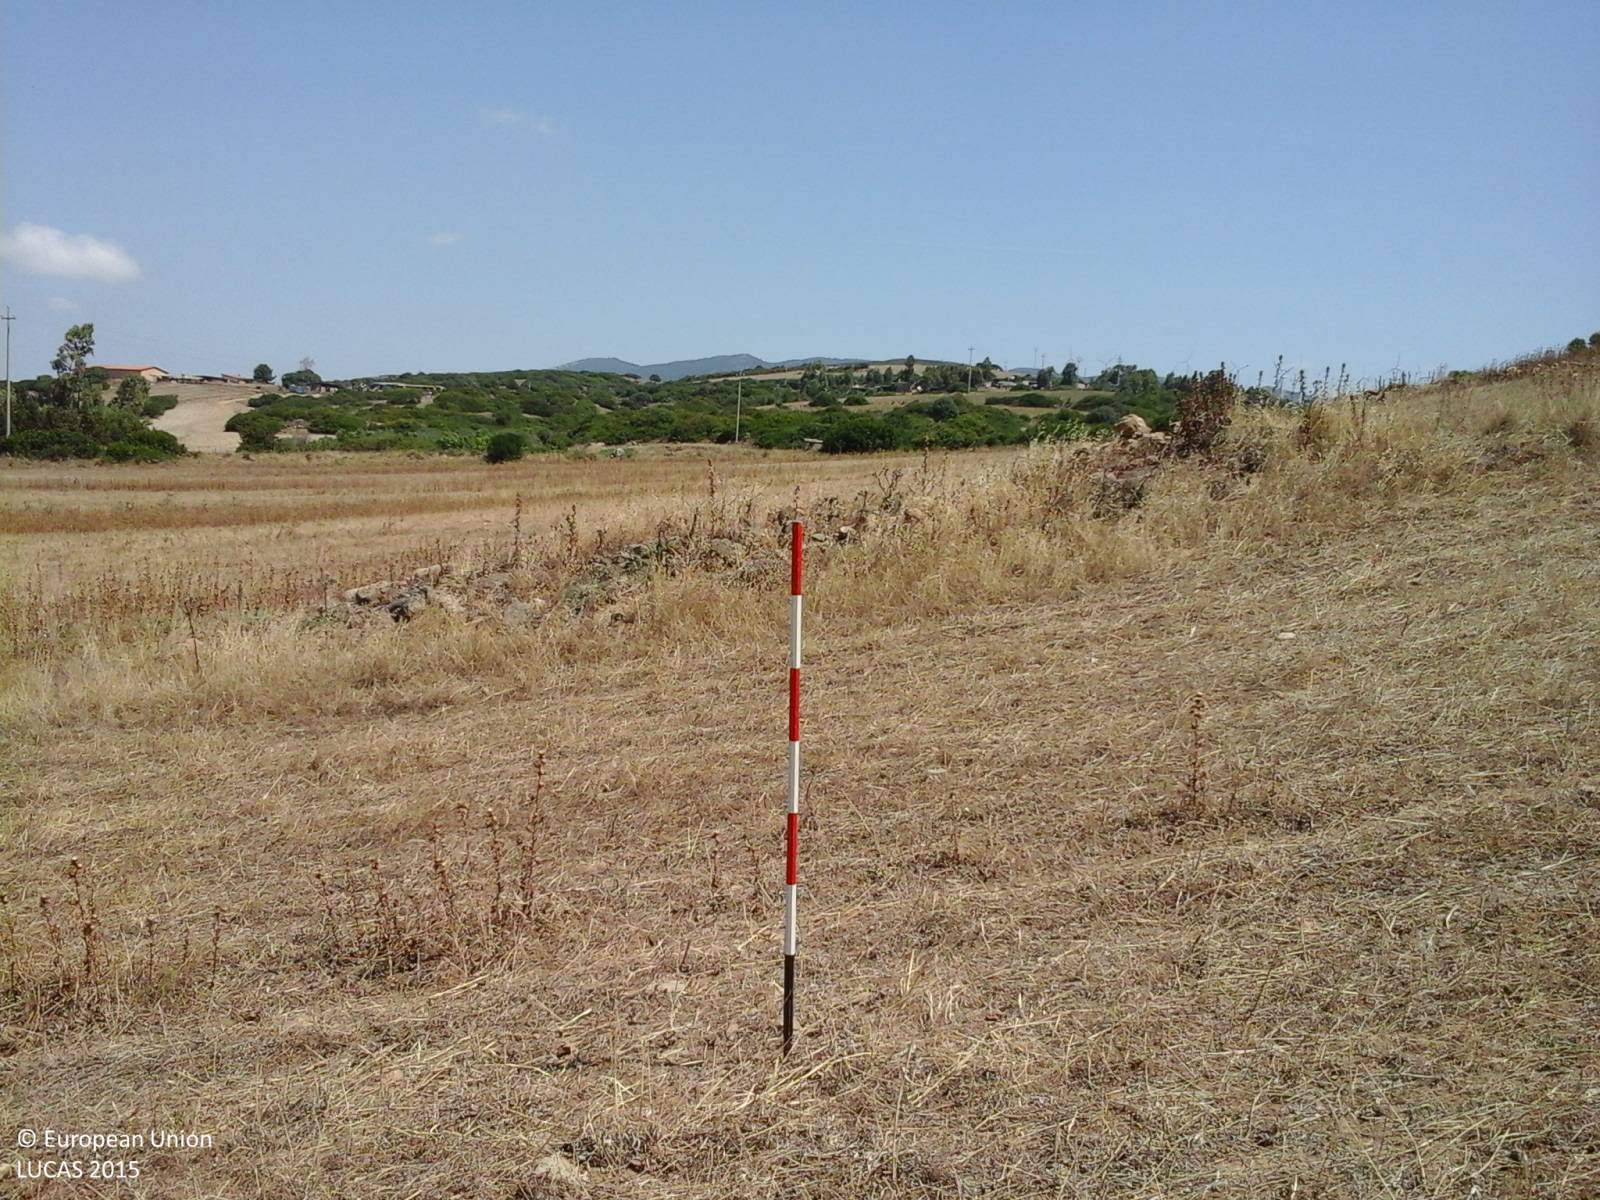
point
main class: Cropland
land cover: Mixed cereals for fodder
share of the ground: > 75 %
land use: Agriculture (excluding fallow land and kitchen gardens)
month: June
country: IT
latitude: 39.8798
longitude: 8.8023
